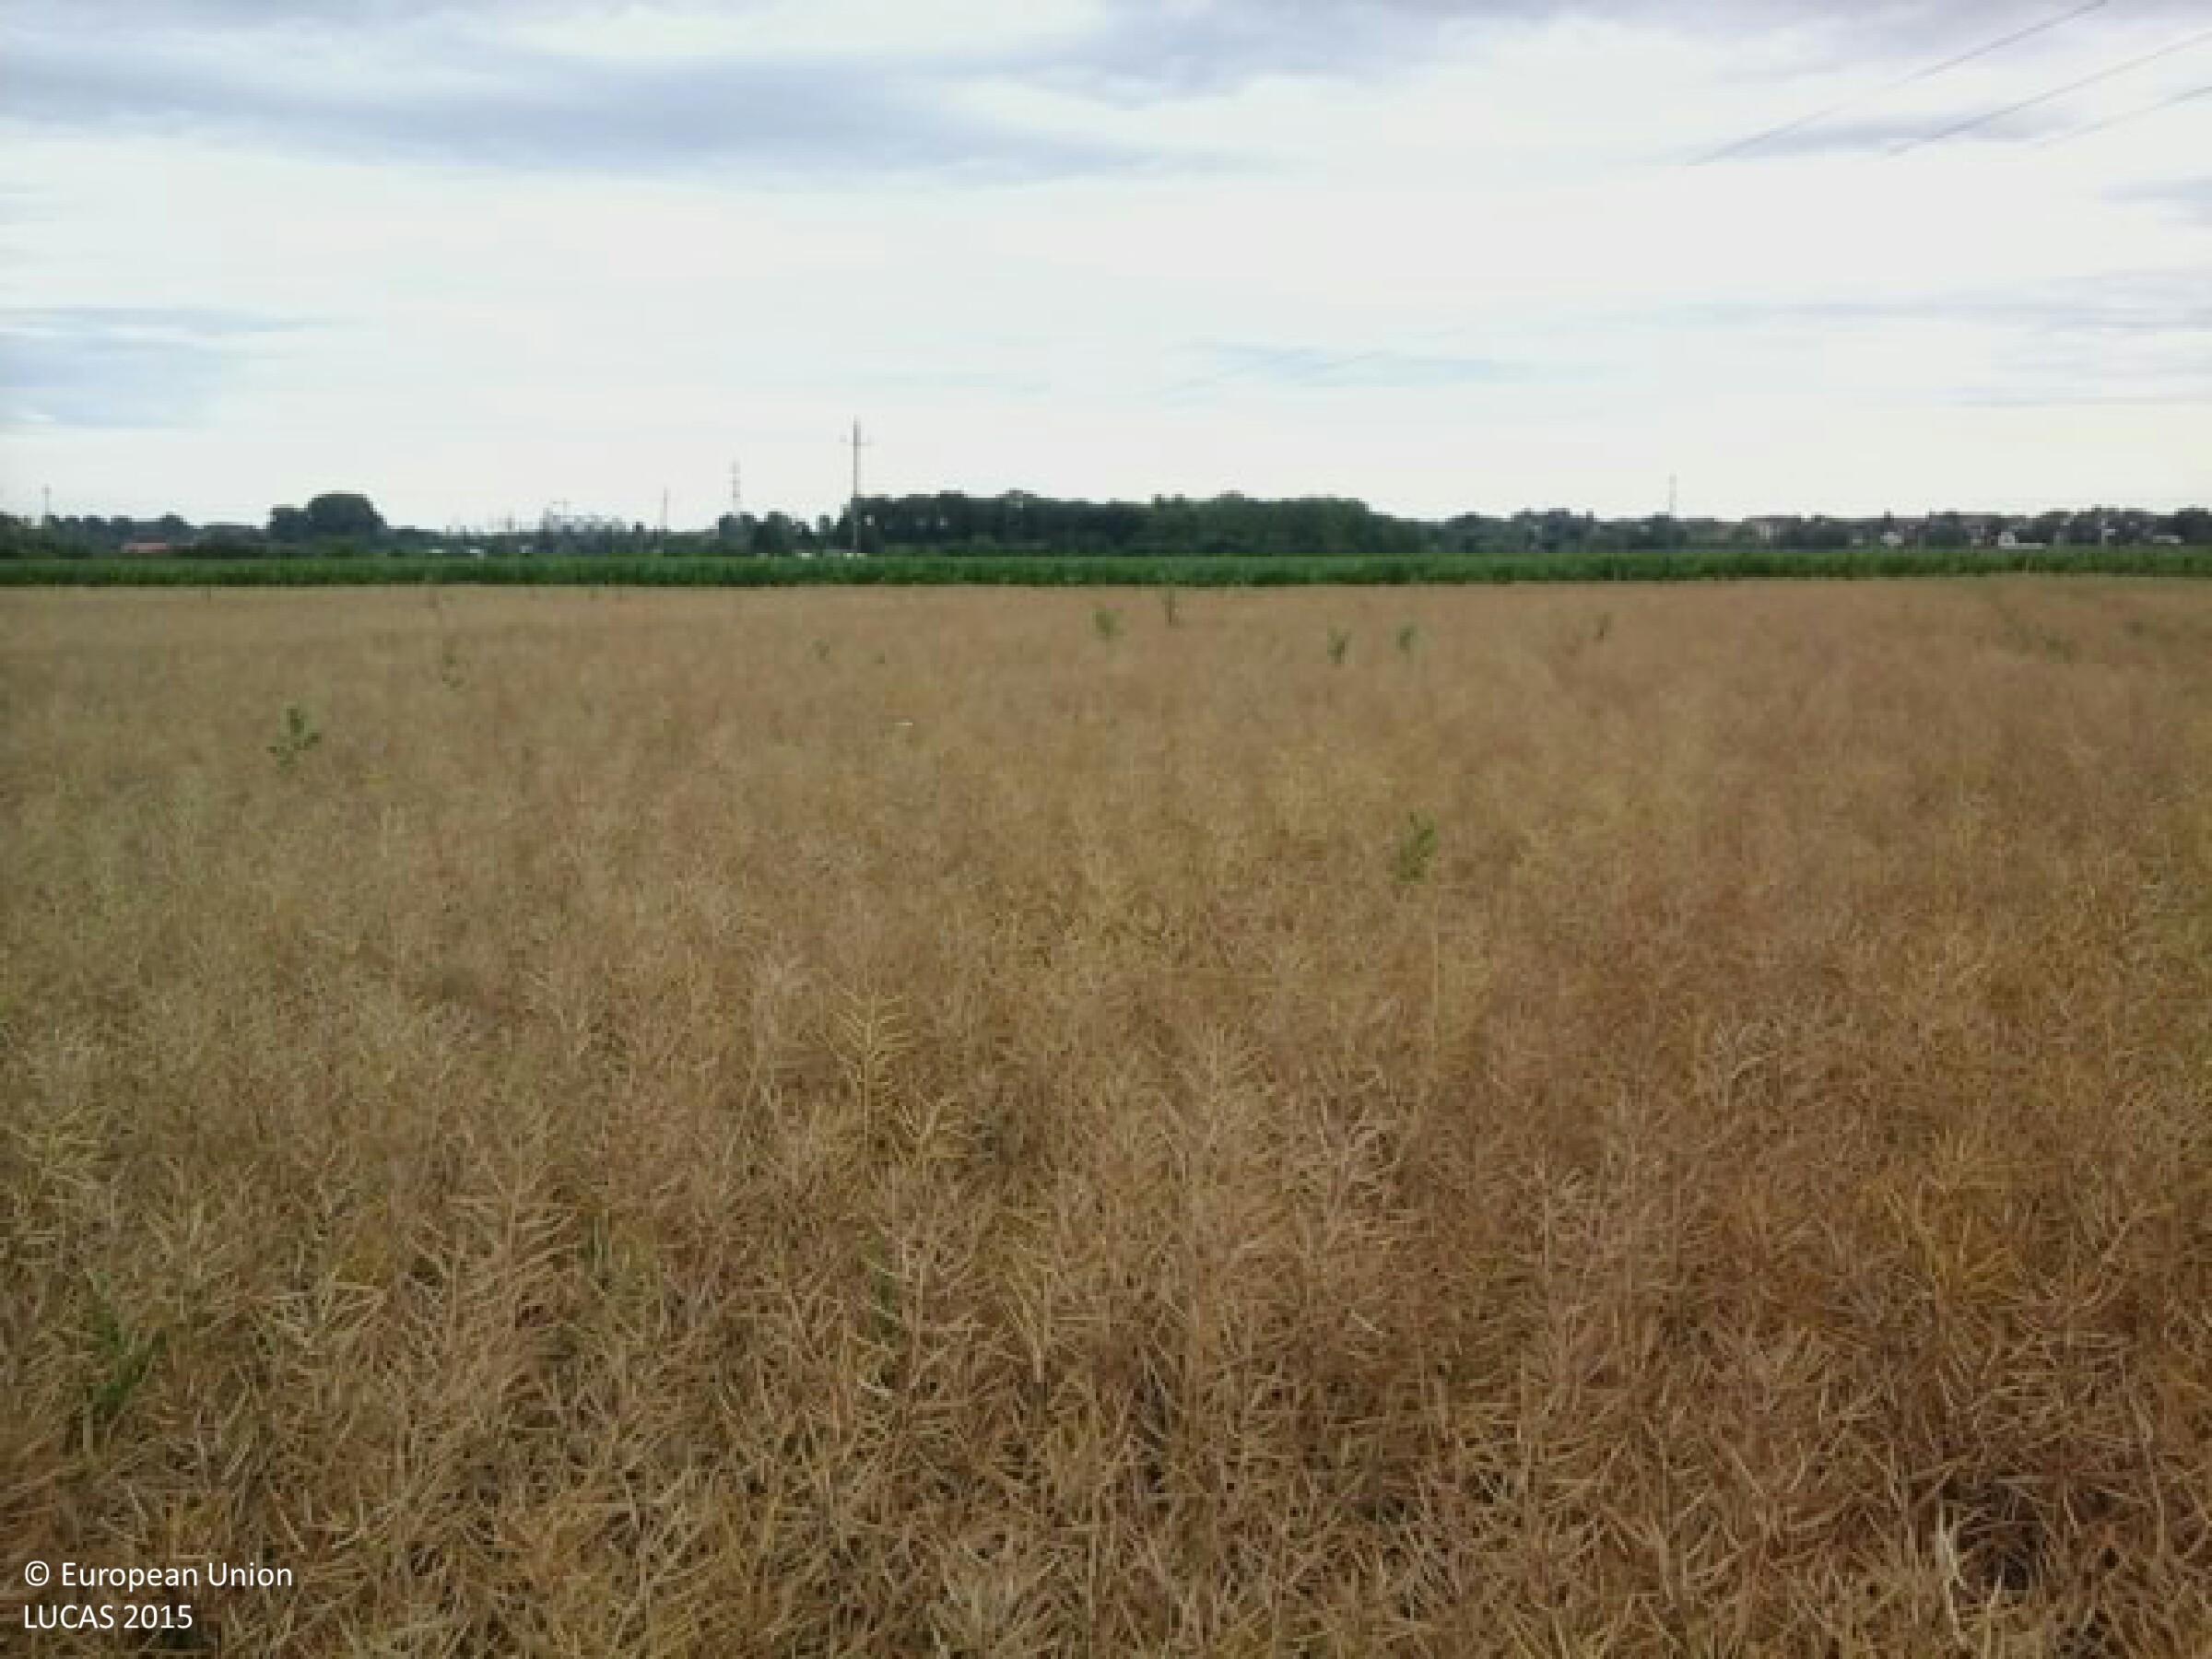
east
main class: Cropland
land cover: Rape and turnip rape
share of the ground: > 75 %
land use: Agriculture (excluding fallow land and kitchen gardens)
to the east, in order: Rape and turnip rape; Grass margins; Tracks; Grass margins; Maize; Electric lines; Maize
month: June
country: HU
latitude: 46.2115
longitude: 18.9428
